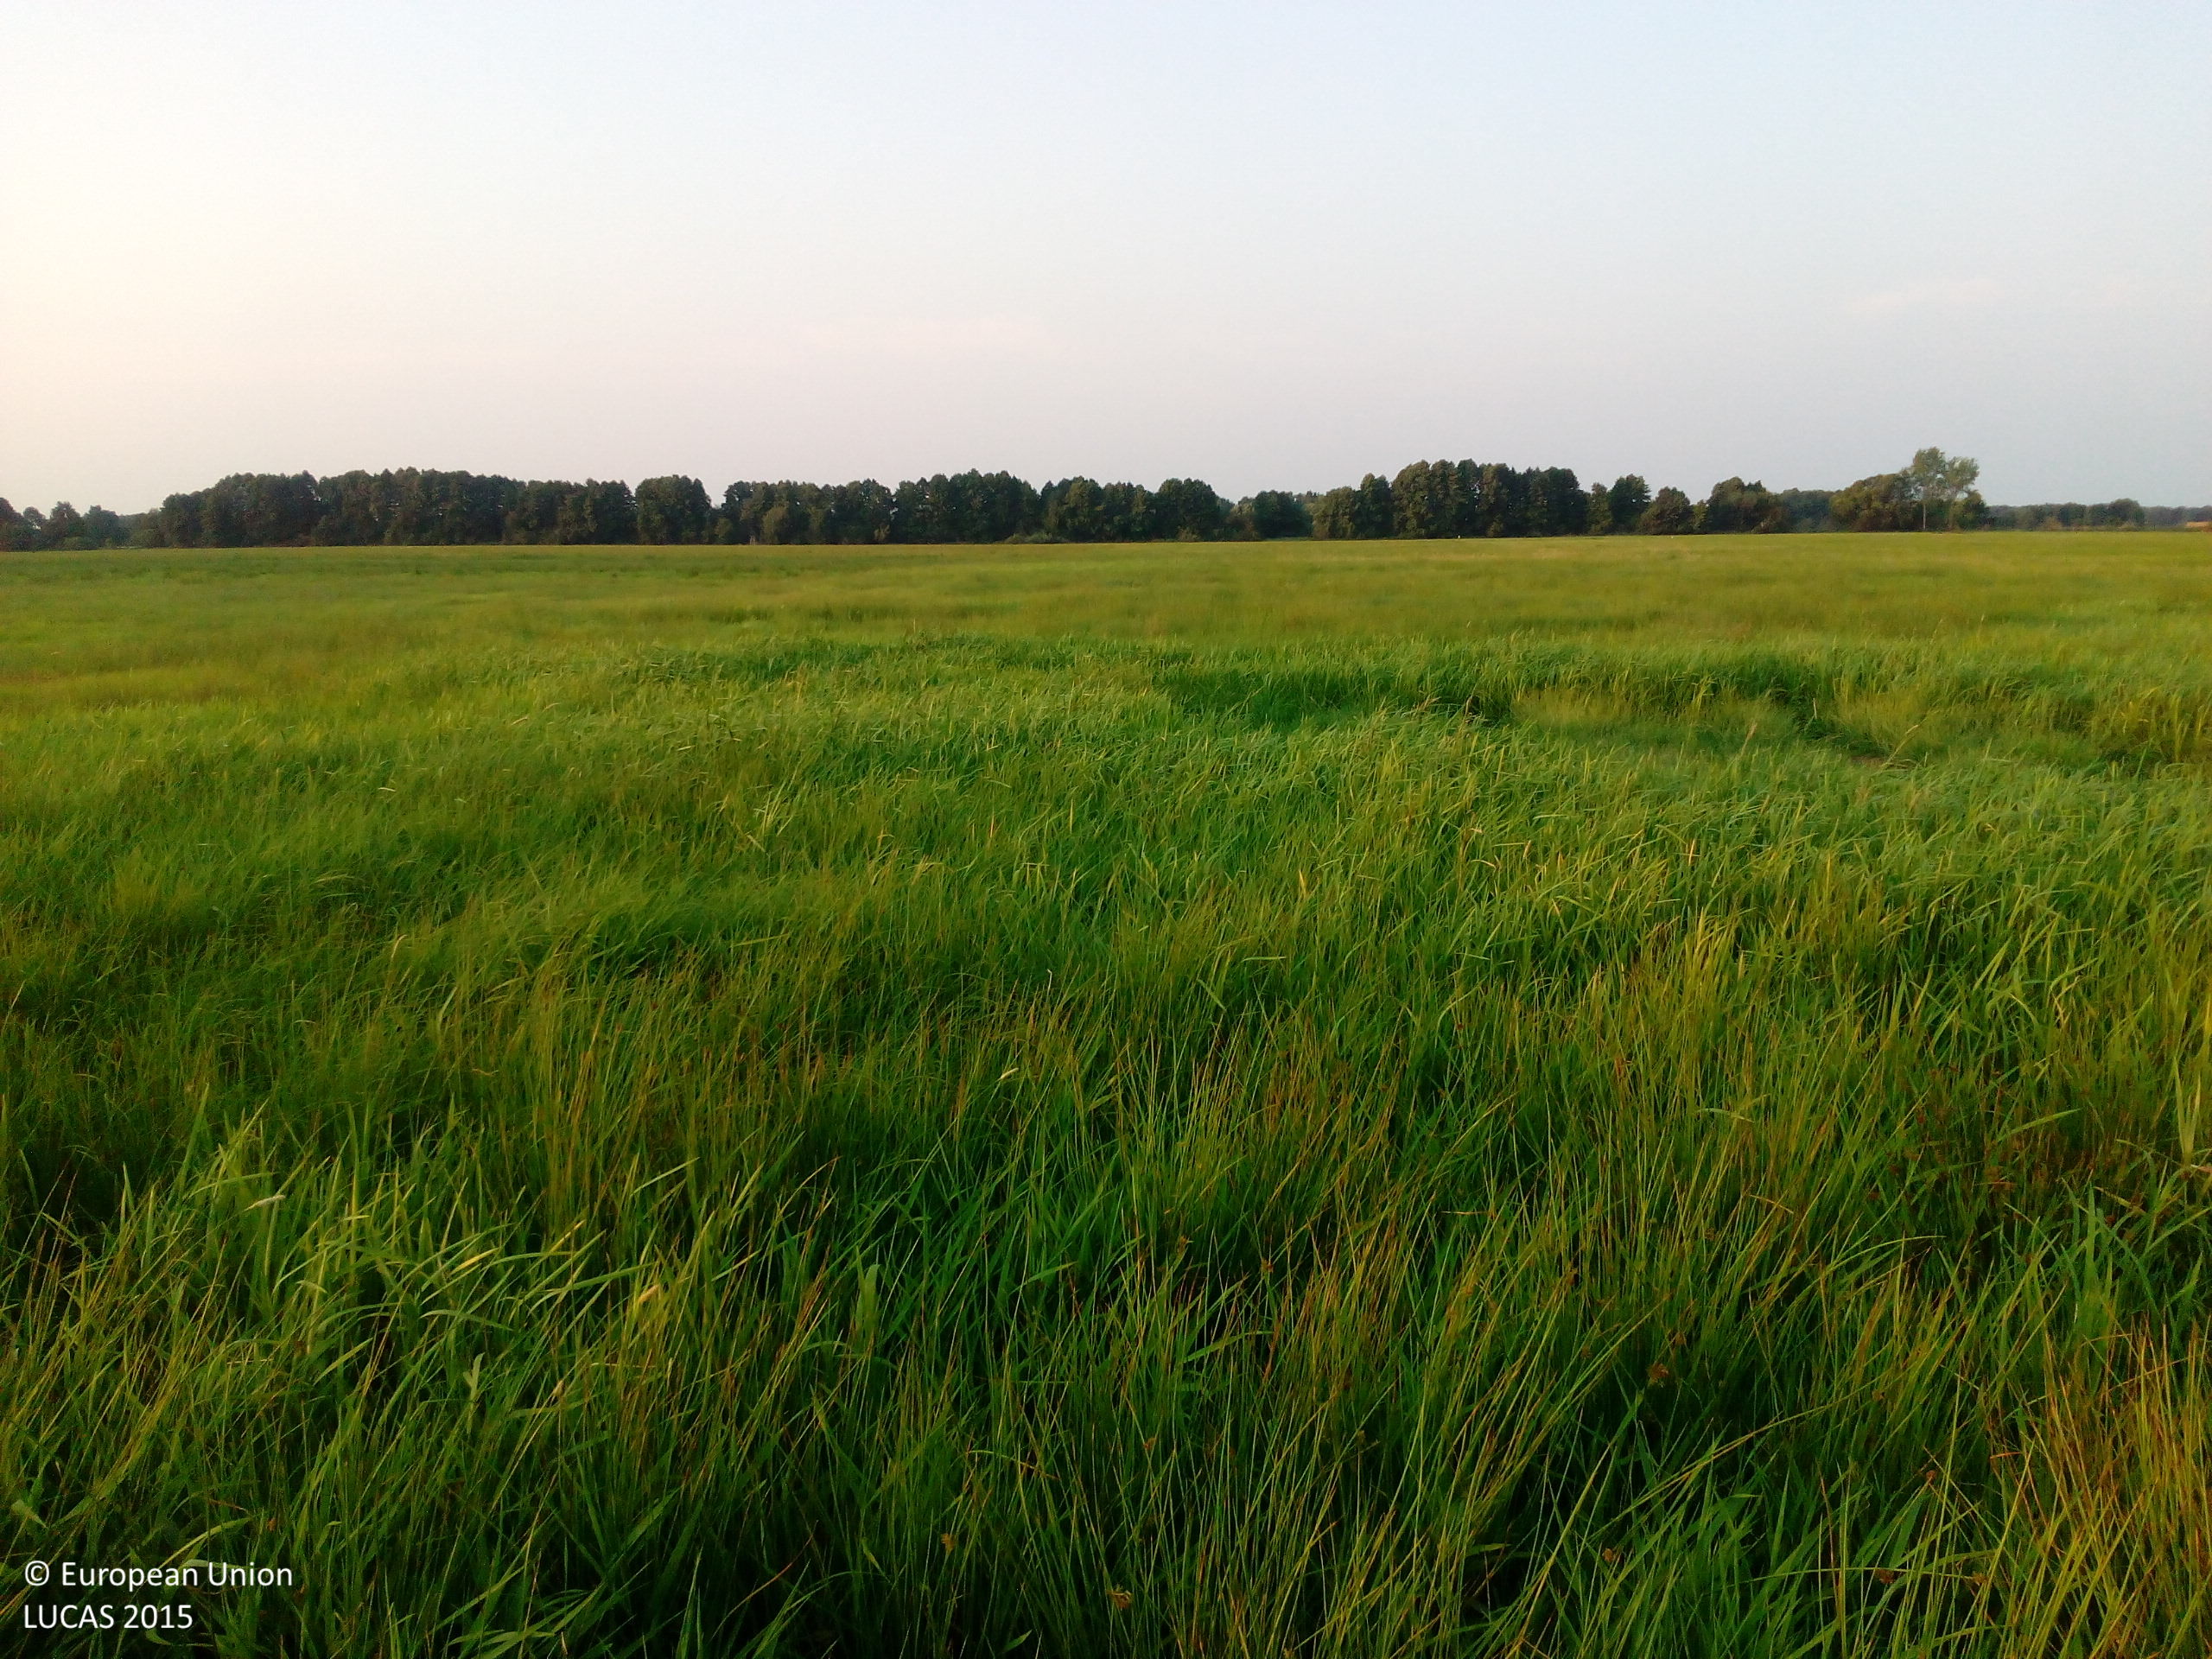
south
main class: Grassland
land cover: Grassland without tree/shrub cover
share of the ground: > 75 %
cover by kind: herbaceous plants 100 %
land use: Agriculture (excluding fallow land and kitchen gardens)
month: August
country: DE
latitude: 51.8470
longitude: 14.3709
